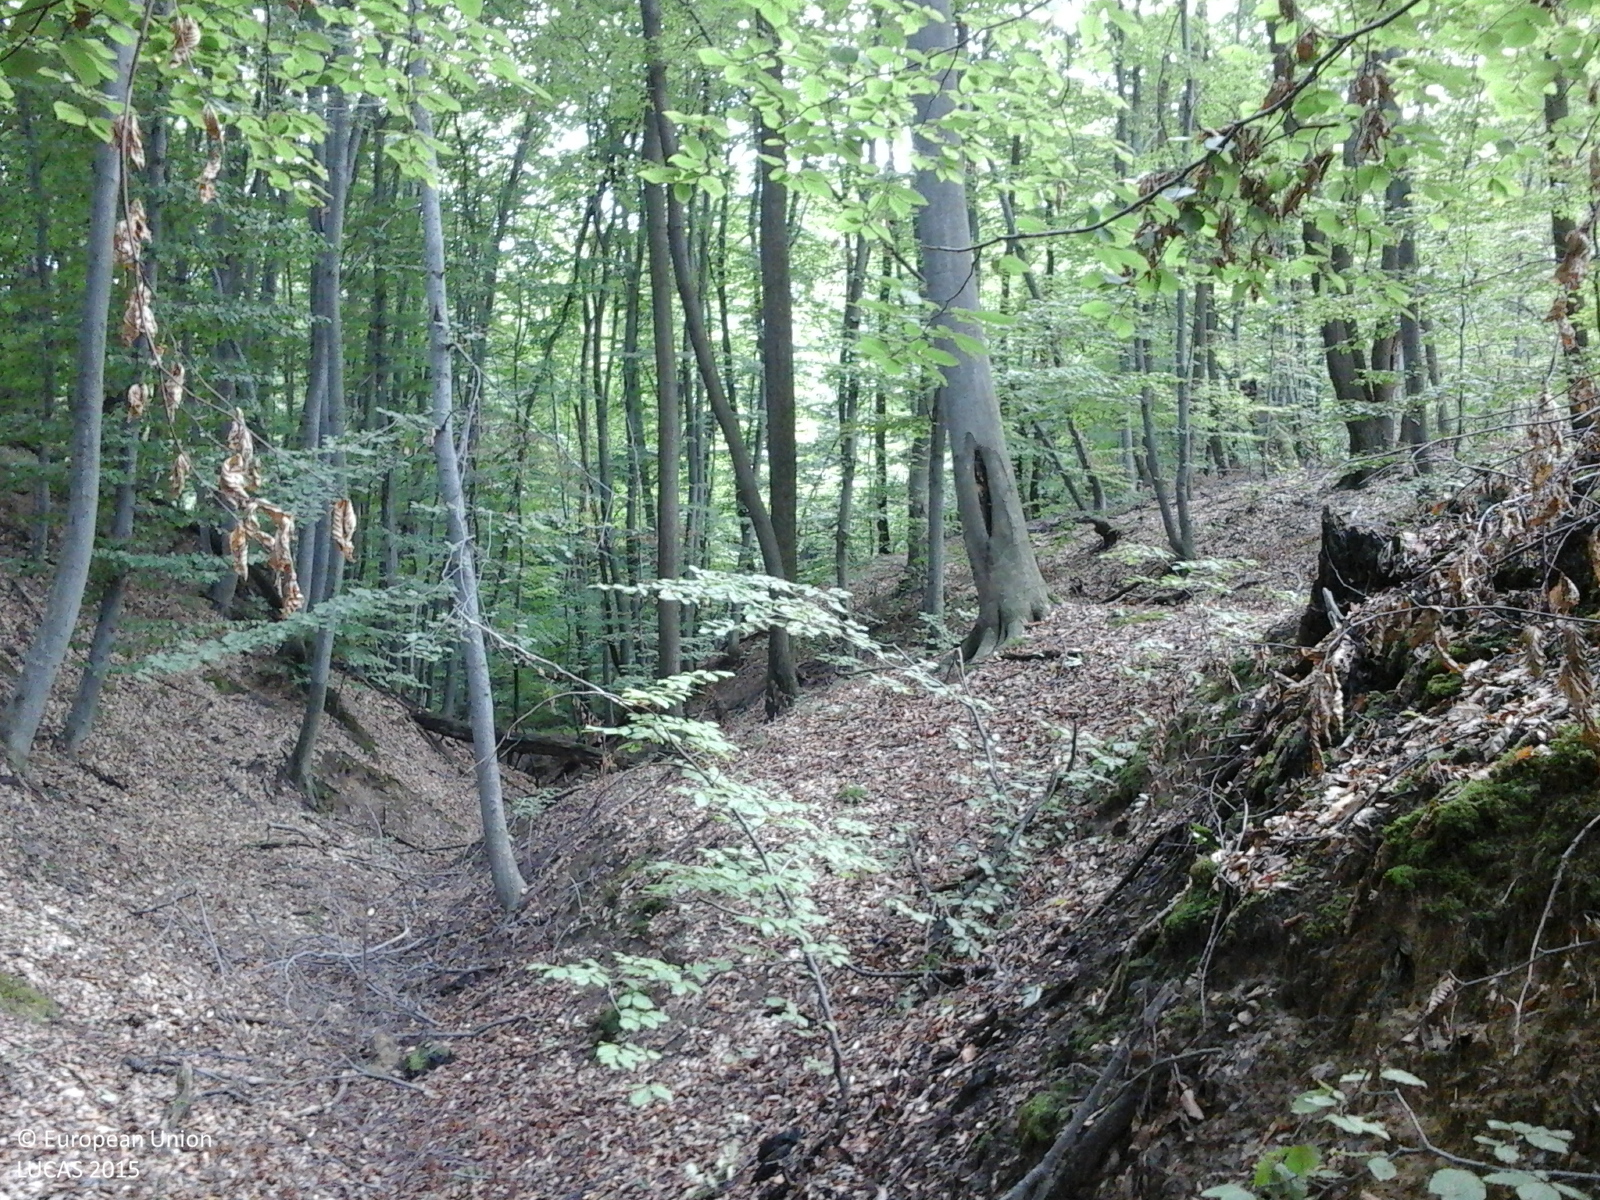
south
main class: Woodland
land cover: Broadleaved woodland
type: acidophilous oak and oak-birch forest
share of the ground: > 75 %
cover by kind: broadleaved forest trees 100 %
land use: Forestry
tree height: > 5 m
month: September
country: RO
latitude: 45.8402
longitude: 23.3351
